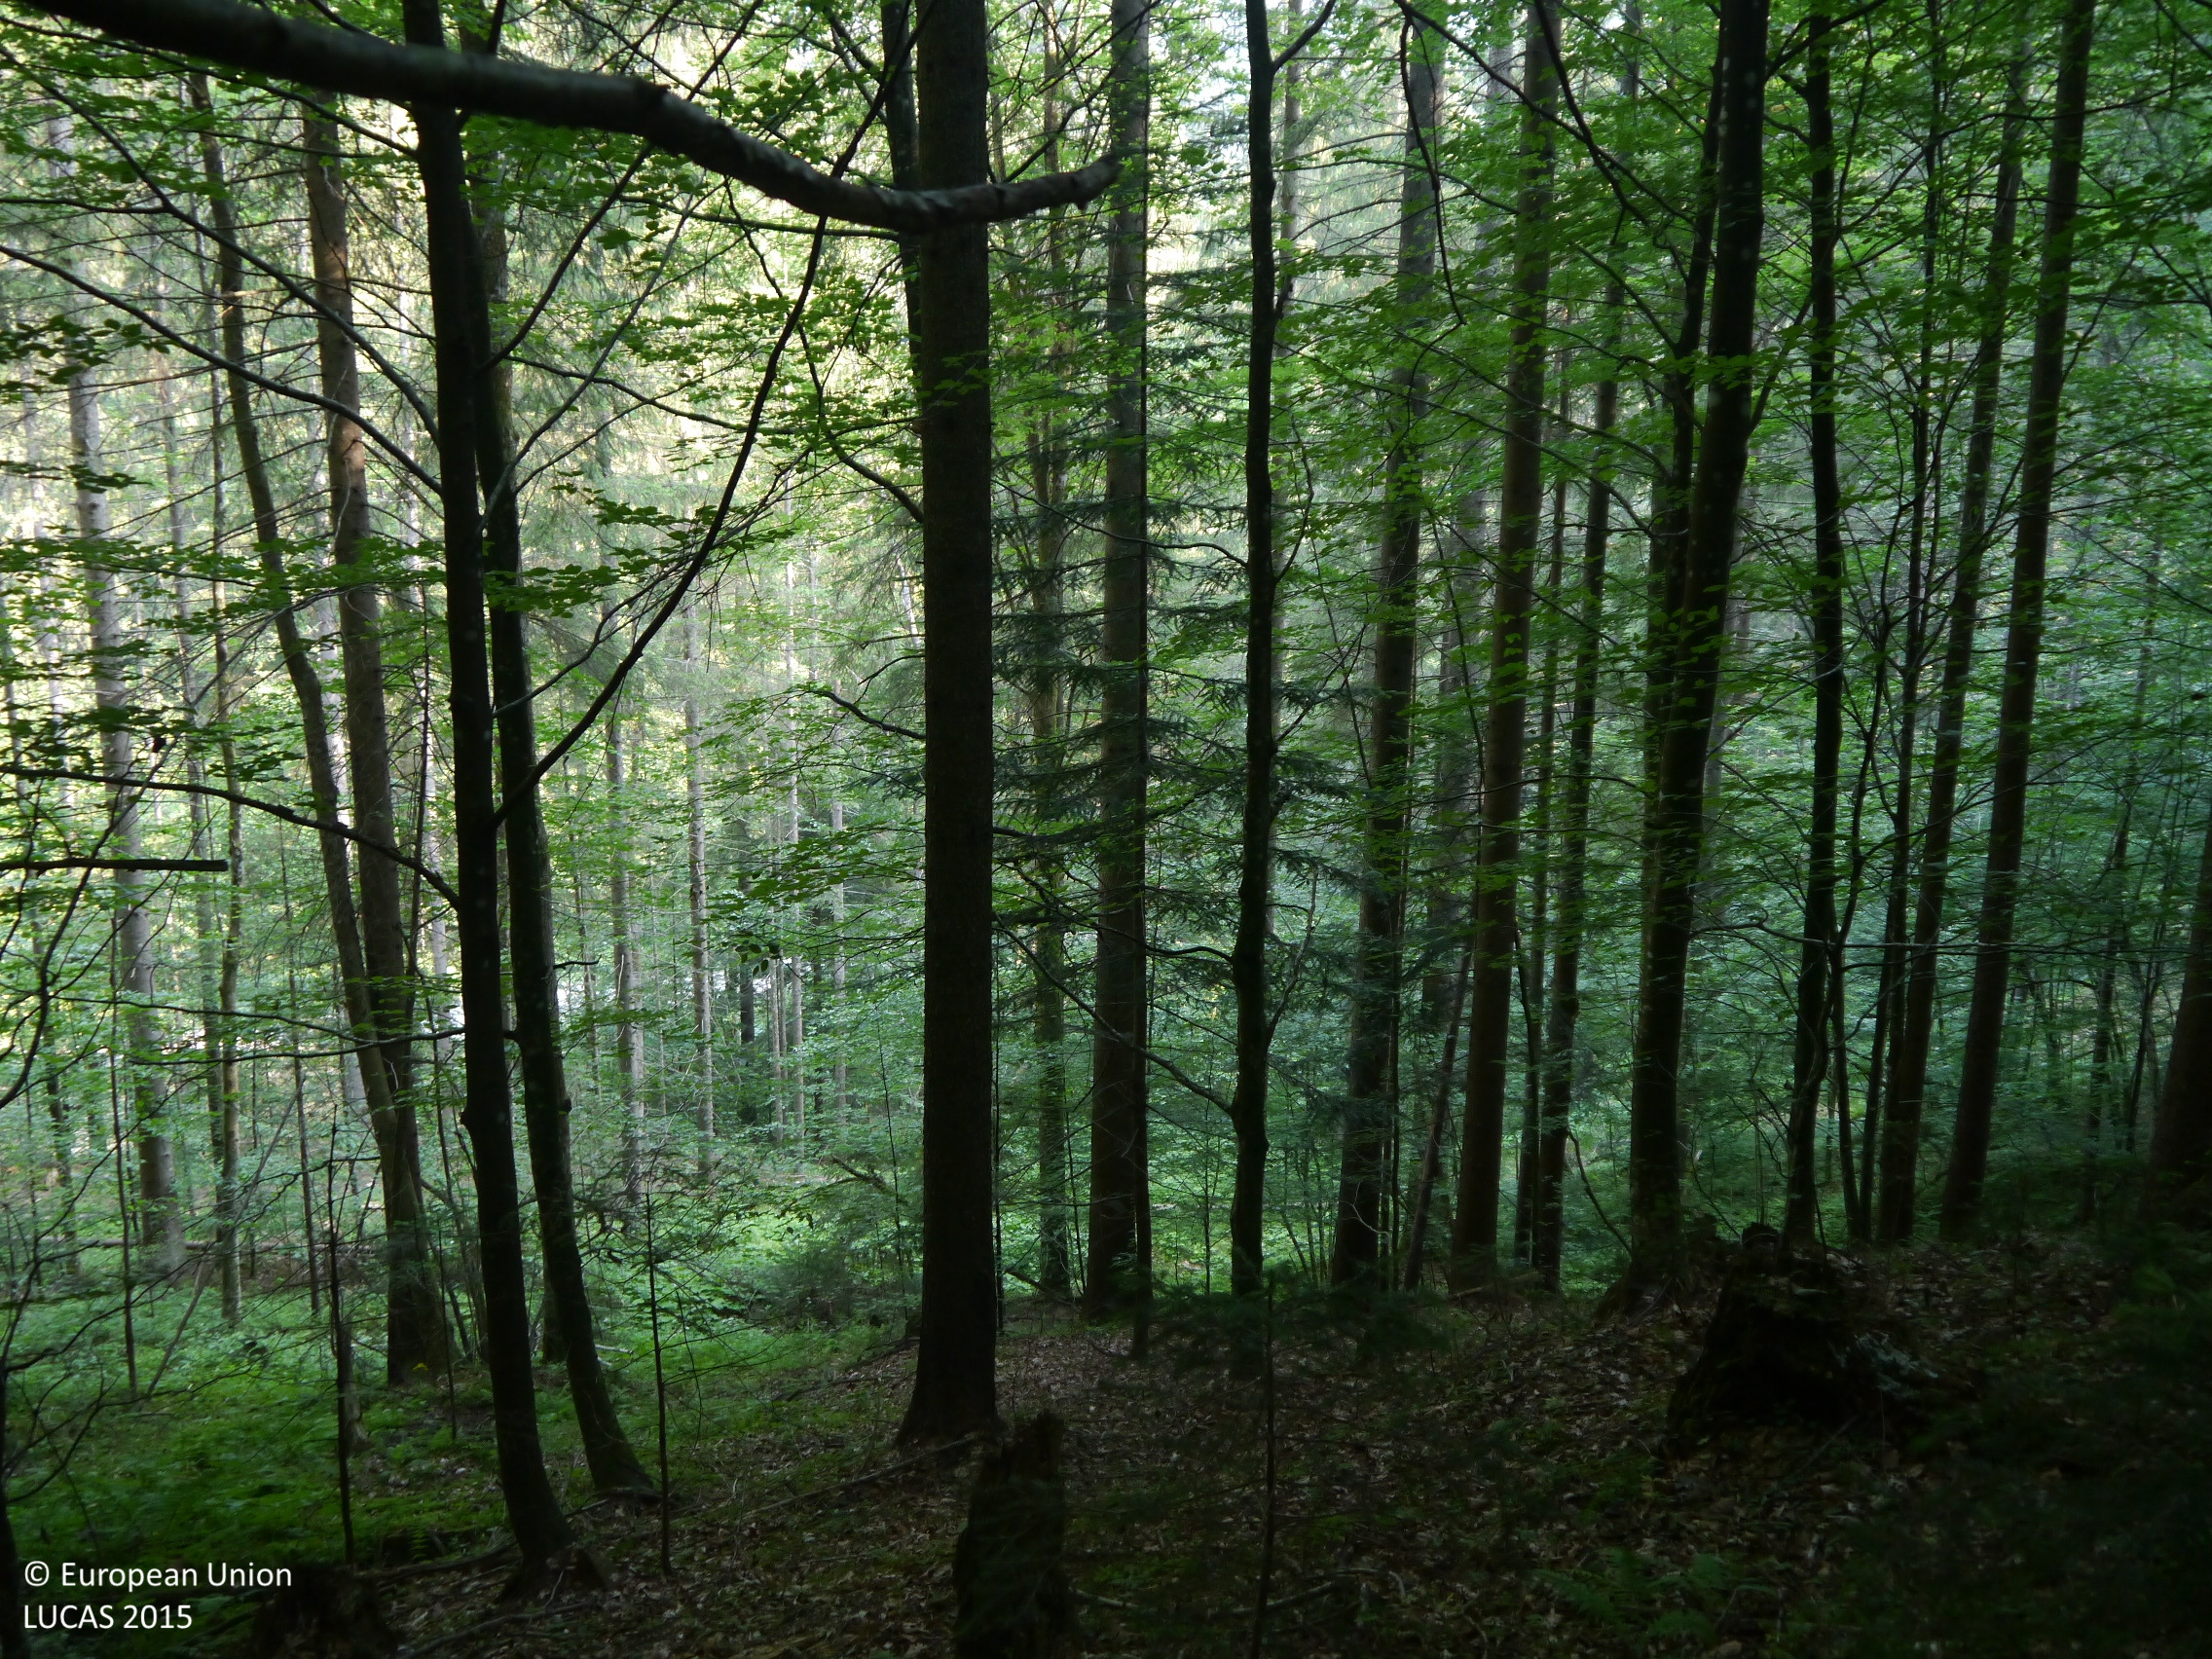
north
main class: Woodland
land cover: Spruce dominated mixed woodland
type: mountainous beech forest
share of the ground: > 75 %
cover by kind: broadleaved forest trees 60 %, coniferous forest trees 25 %, shrubs 10 %, herbaceous plants 5 %
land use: Forestry
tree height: > 5 m
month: June
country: AT
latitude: 46.8047
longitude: 15.1485
